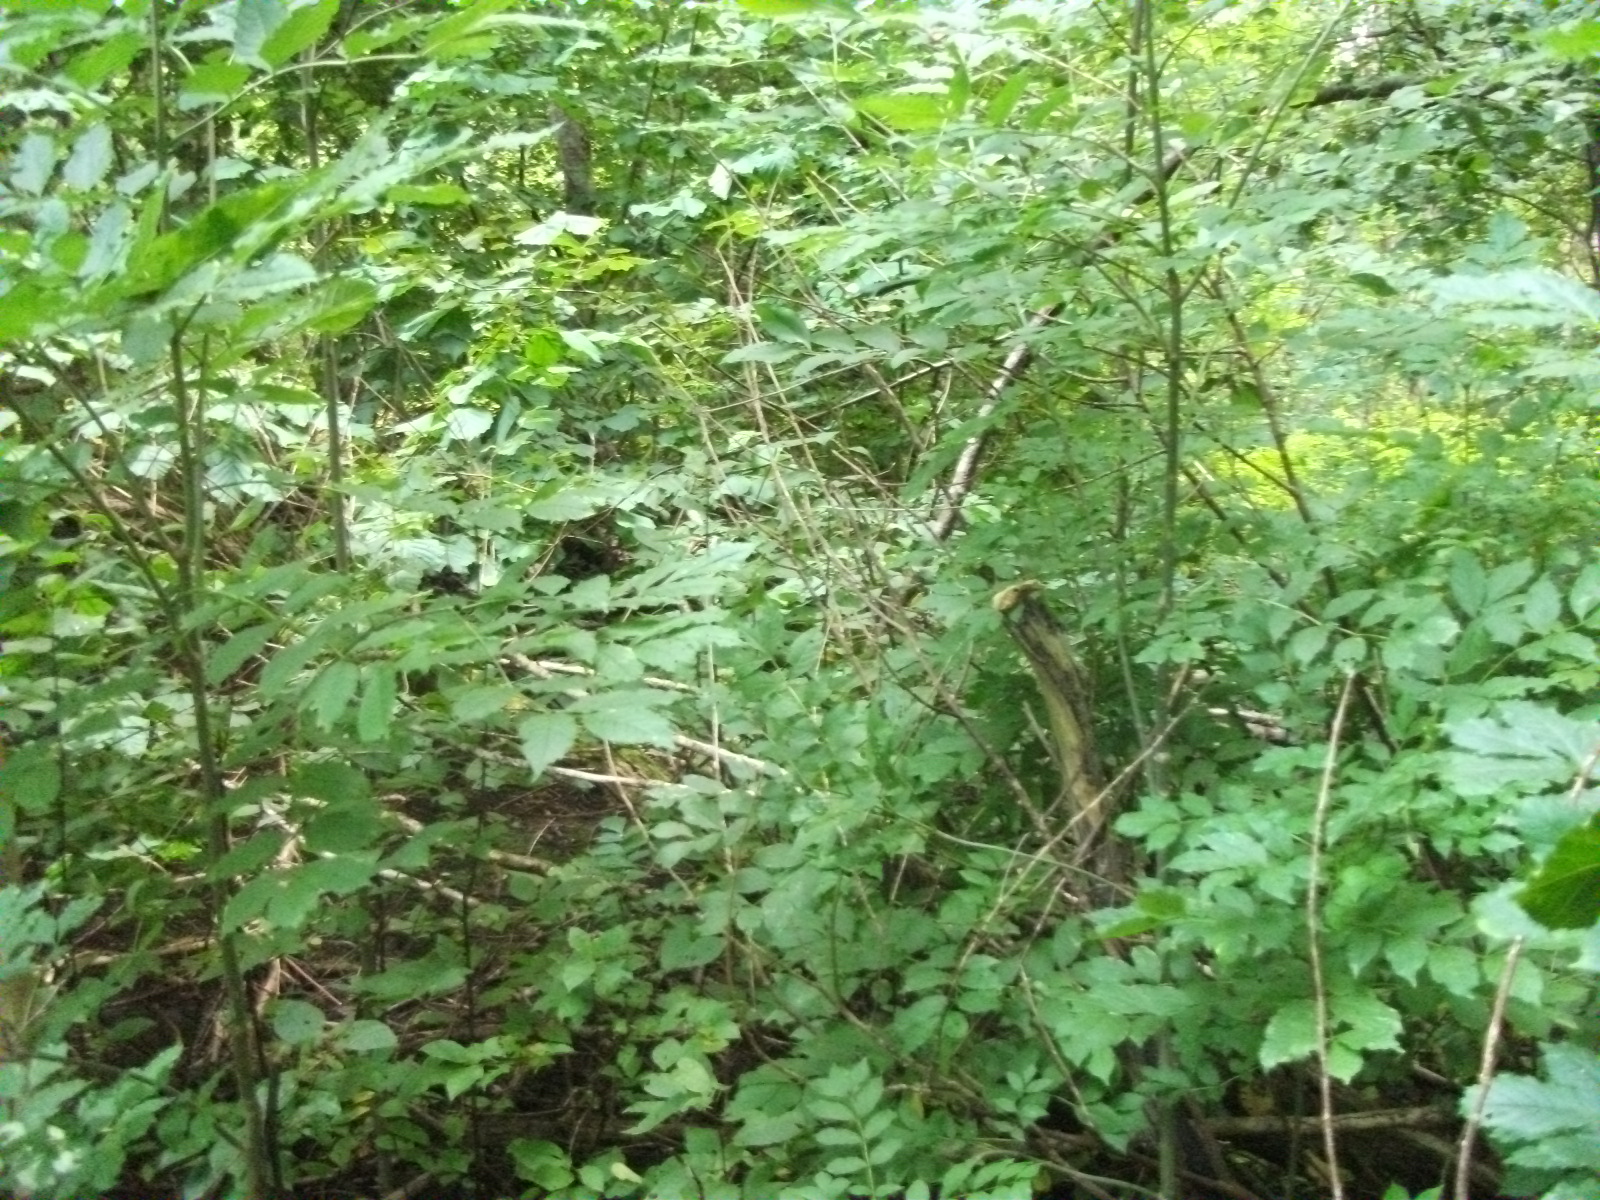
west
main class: Woodland
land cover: Broadleaved woodland
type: non-riverine alder, birch or aspen forest
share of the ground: > 75 %
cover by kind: broadleaved forest trees 85 %, shrubs 10 %, herbaceous plants 5 %
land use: Forestry
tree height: > 5 m
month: August
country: LV
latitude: 56.7579
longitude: 26.5538
